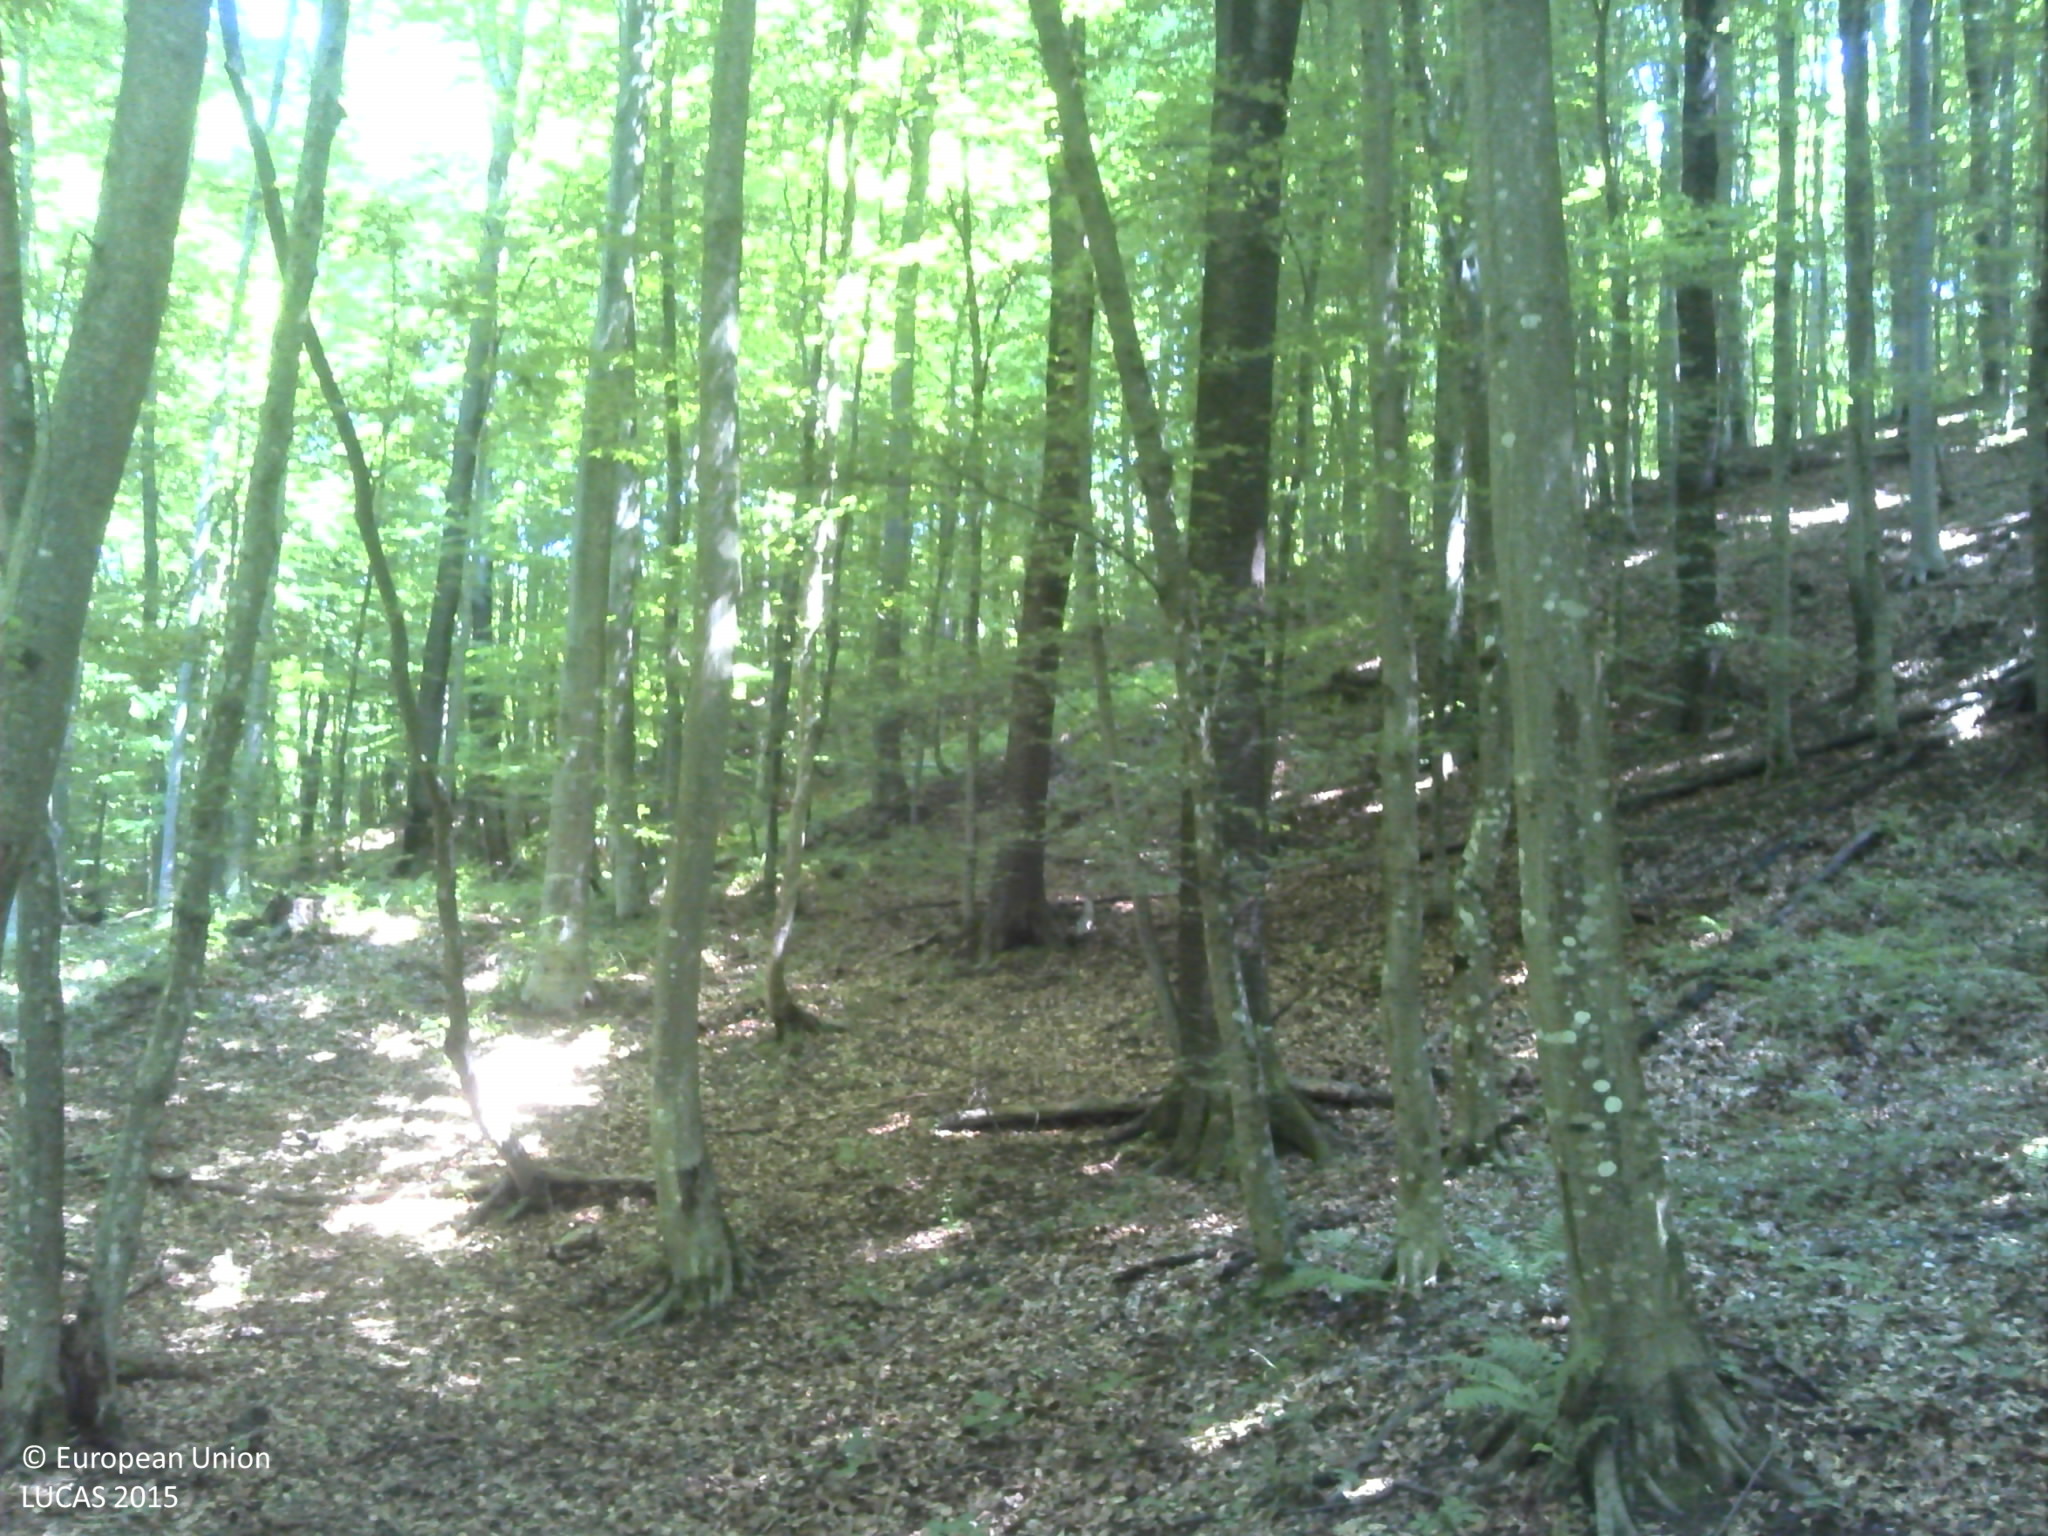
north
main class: Woodland
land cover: Broadleaved woodland
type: beech forest
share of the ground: > 75 %
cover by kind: broadleaved forest trees 90 %, shrubs 5 %, herbaceous plants 5 %
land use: Forestry
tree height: > 5 m
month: June
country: HR
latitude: 45.5863
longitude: 17.6801
